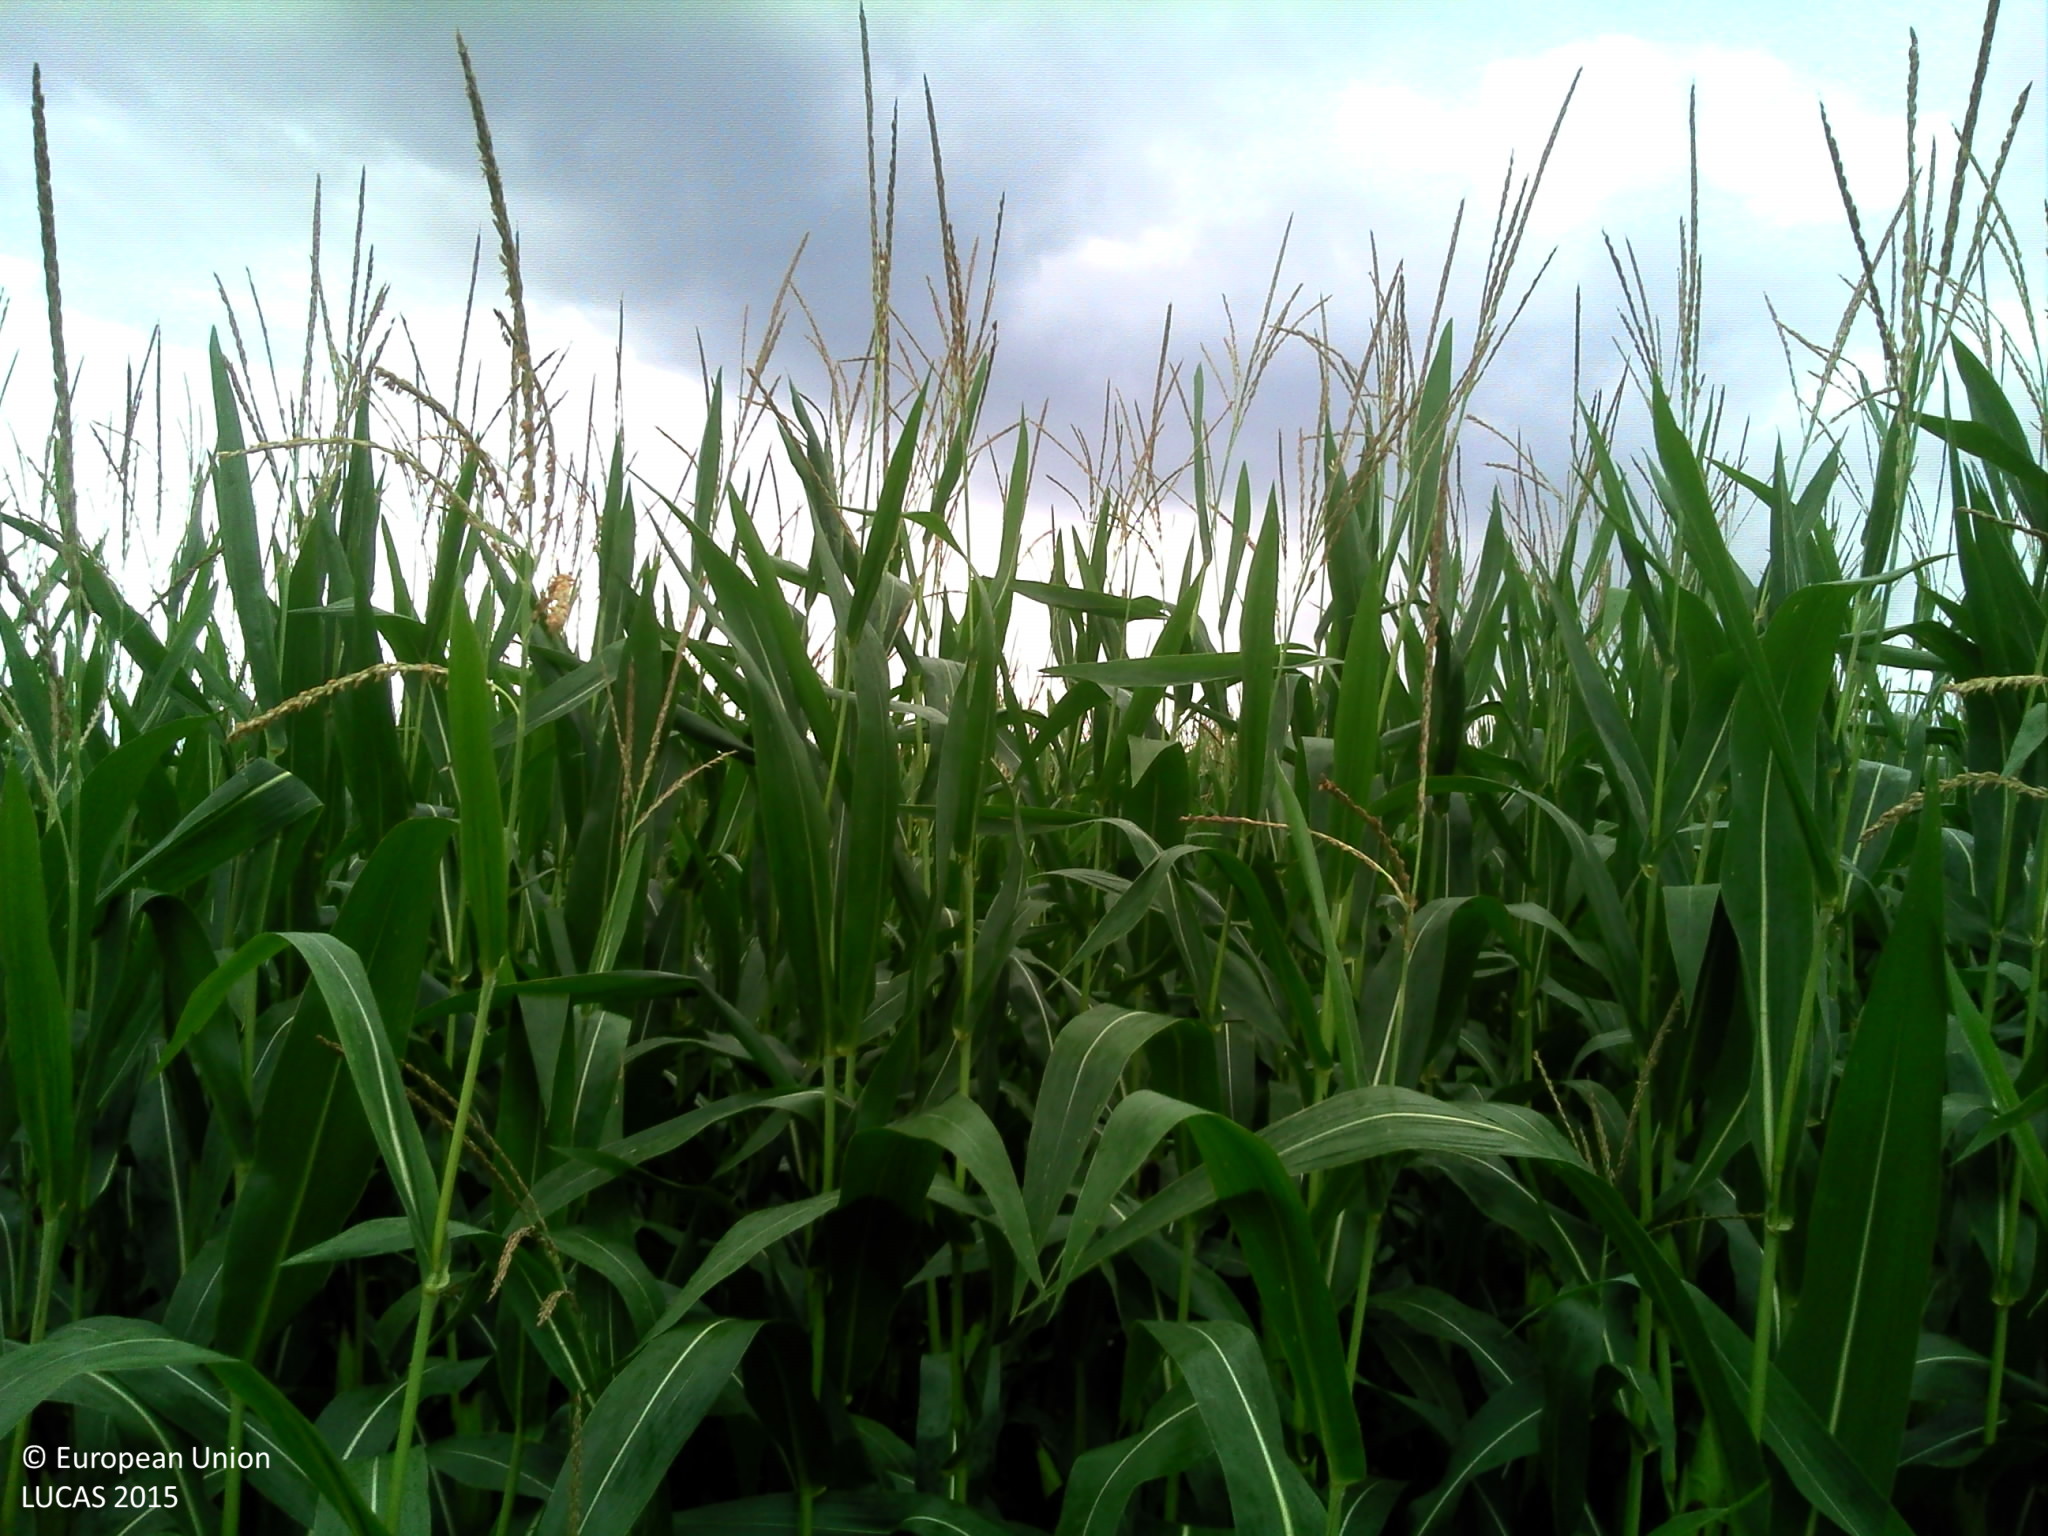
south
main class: Cropland
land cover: Maize
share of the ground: > 75 %
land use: Agriculture (excluding fallow land and kitchen gardens)
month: July
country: FR
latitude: 48.9020
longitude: 7.7224
